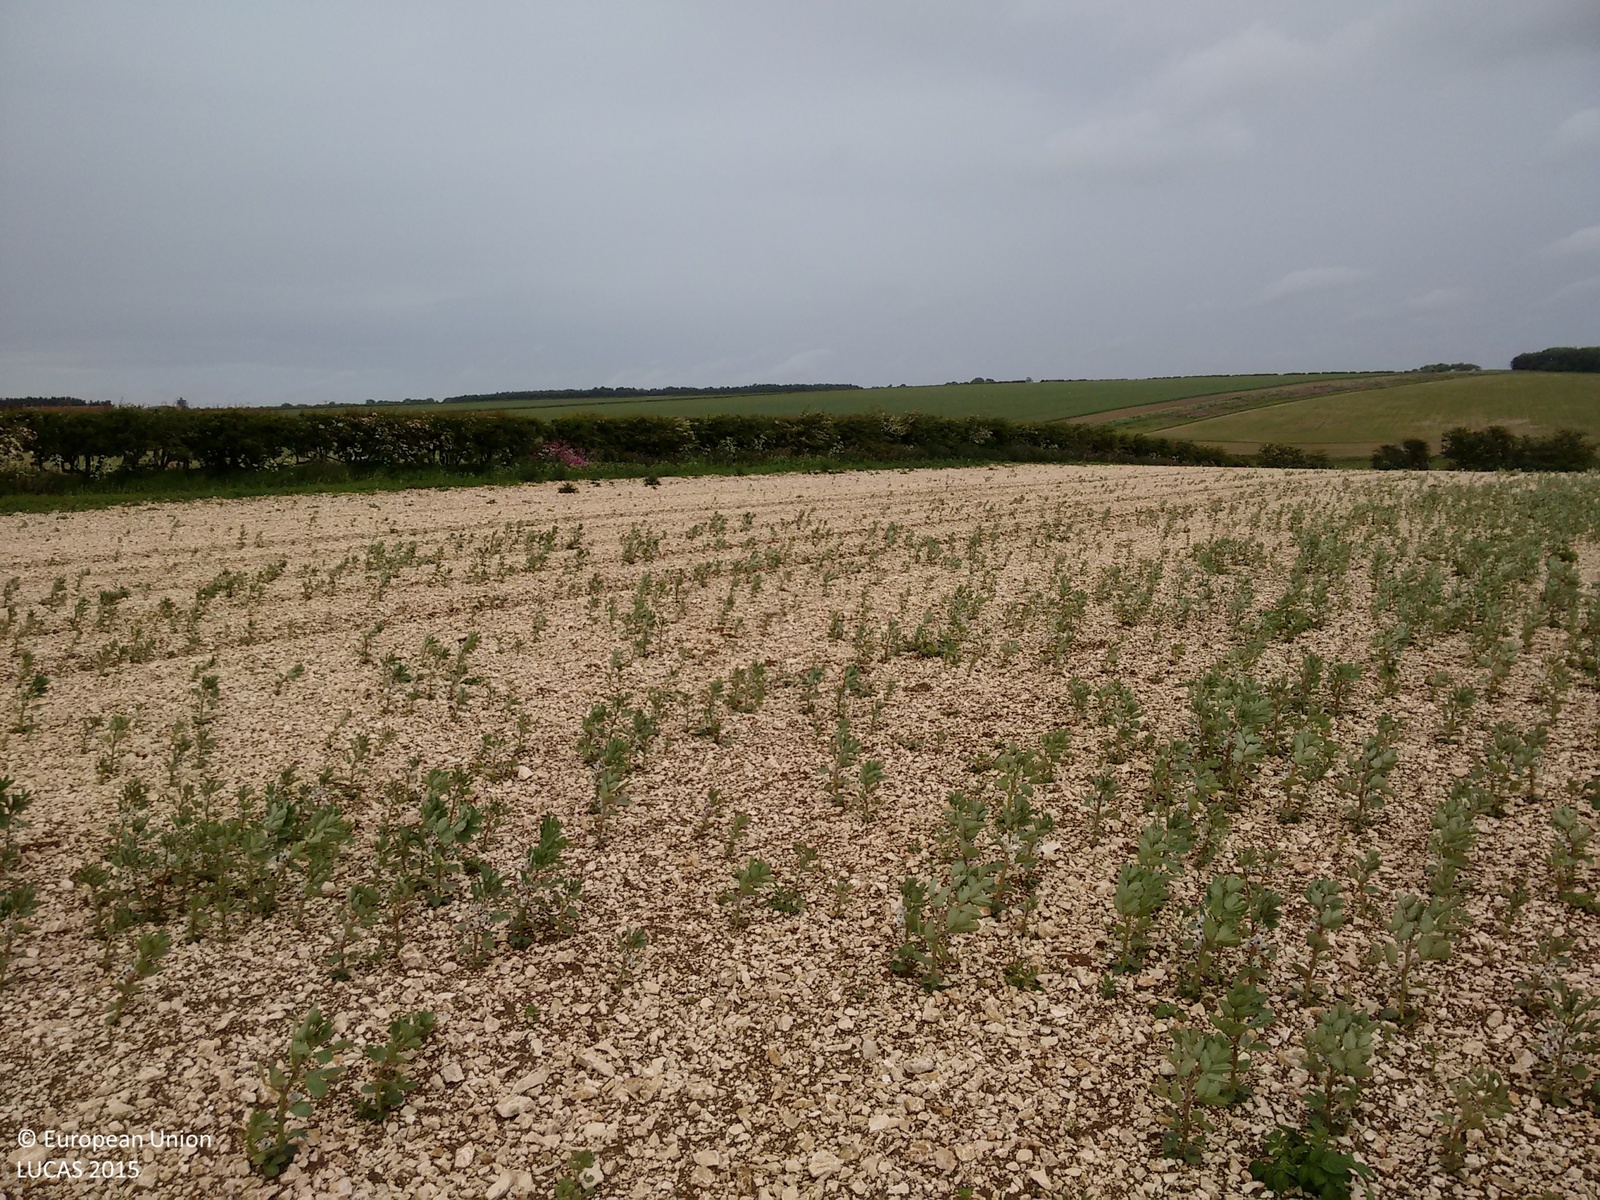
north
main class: Cropland
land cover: Dry pulses
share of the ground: 10 - 25 %
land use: Agriculture (excluding fallow land and kitchen gardens)
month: June
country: GB
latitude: 54.1597
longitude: -0.4959
